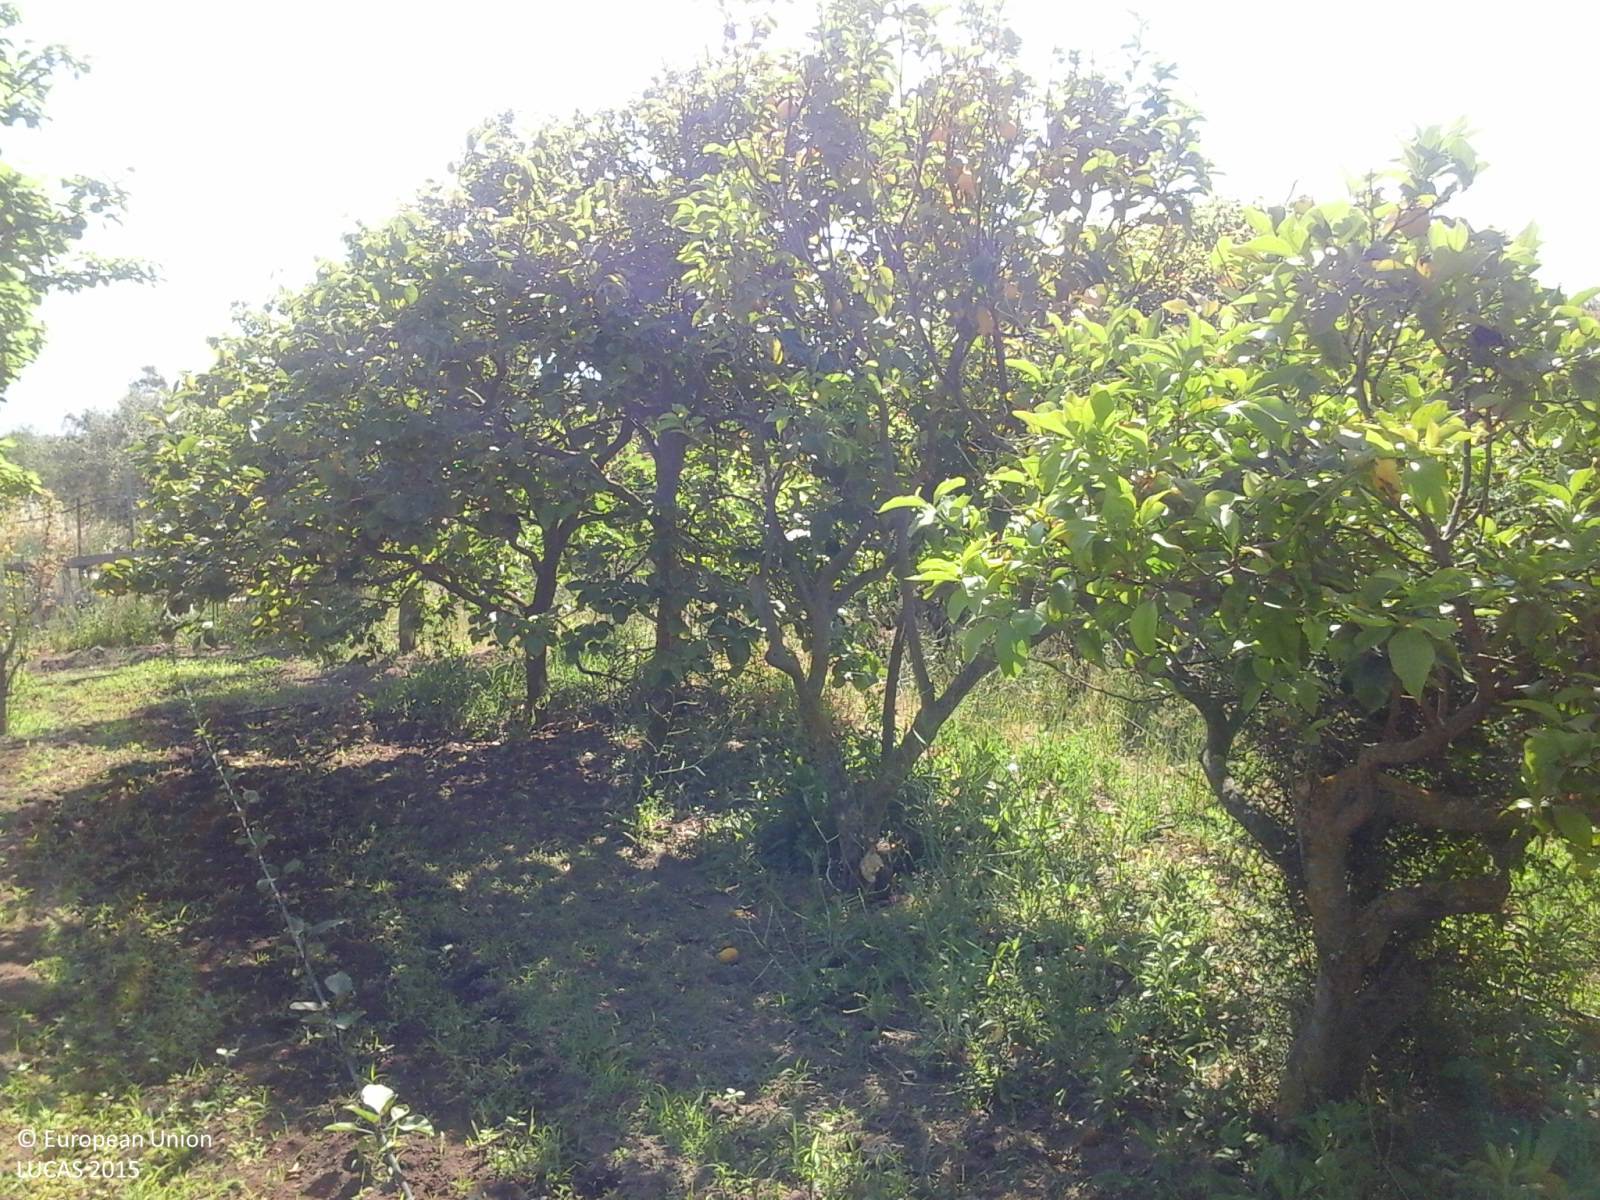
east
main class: Cropland
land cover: Other citrus fruit
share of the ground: < 10 %
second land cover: Other fresh vegetables
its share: < 10 %
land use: Agriculture (excluding fallow land and kitchen gardens)
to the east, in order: Other citrus fruit; Other fresh vegetables; Vineyards; Olive groves; Fences; Abandoned hedges; Olive groves; Vineyards; Lines of trees; Abandoned hedges; Olive groves; Fences; Tracks; Fences; Olive groves; Fences; Tracks; Fences; Tracks; Single bushes/trees; Fences; Grassland without tree/shrub cover
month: June
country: IT
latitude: 40.9116
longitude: 8.8064
